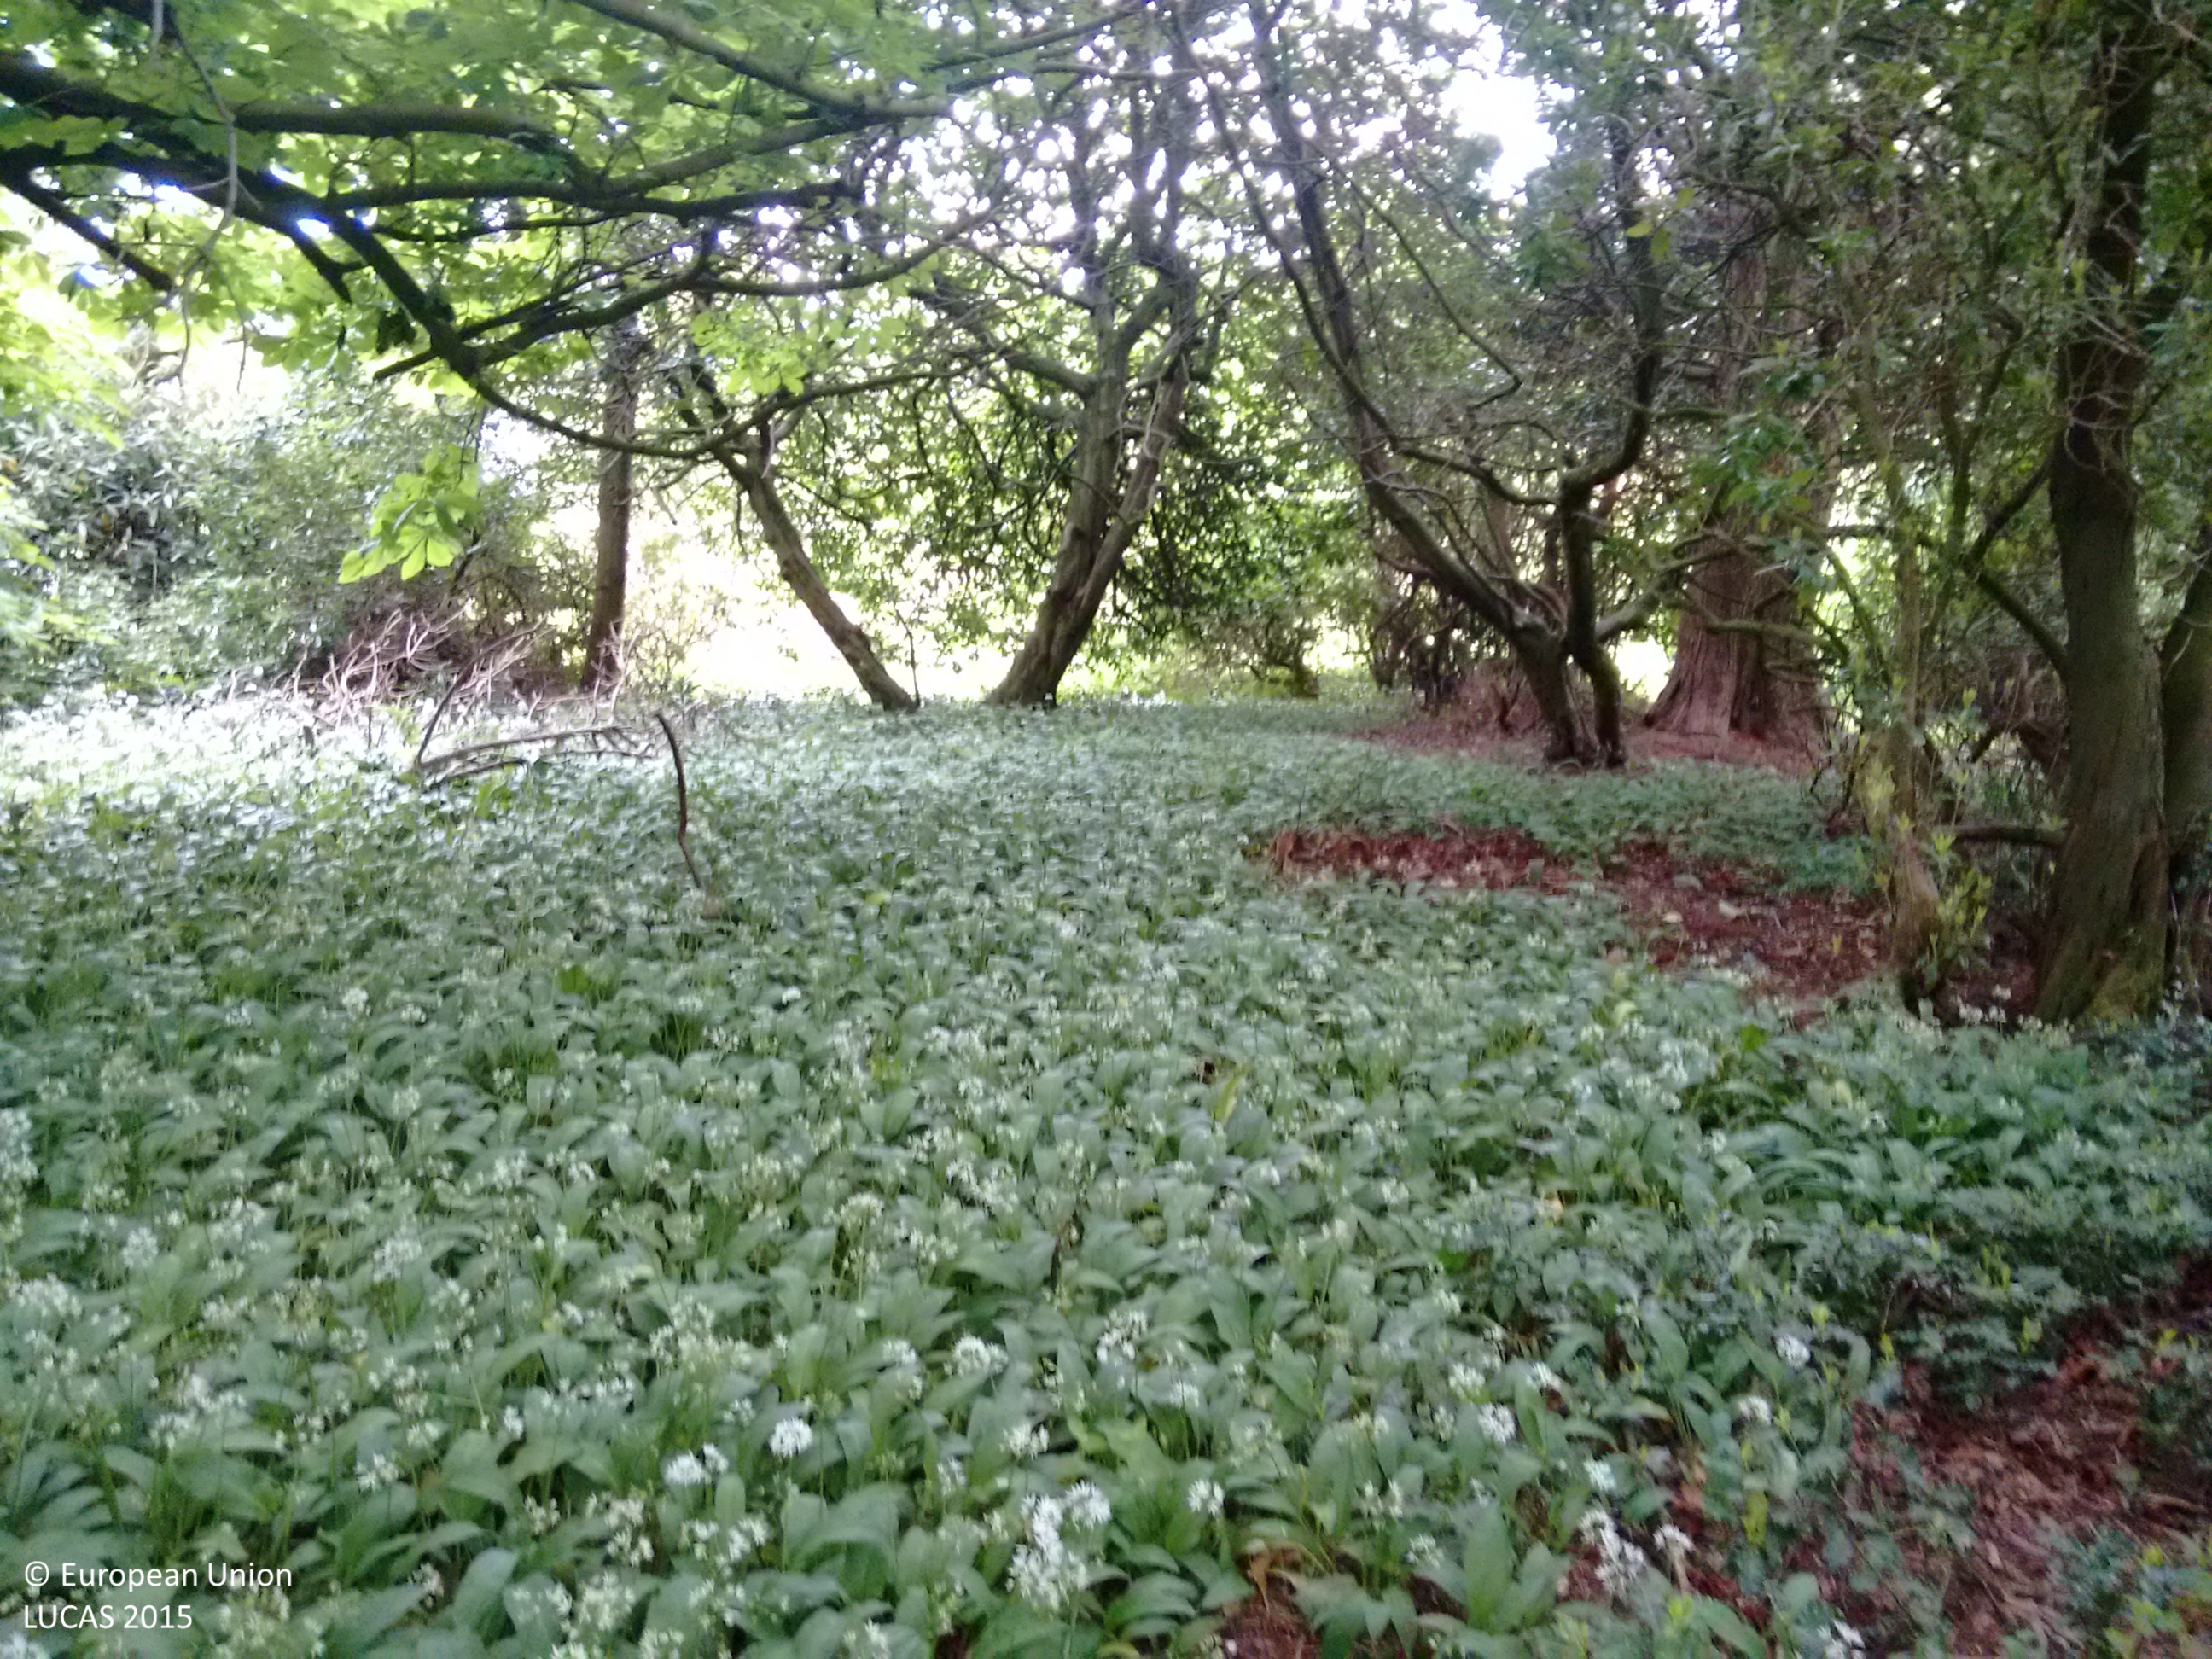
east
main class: Woodland
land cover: Other mixed woodland
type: exotic forest
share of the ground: > 75 %
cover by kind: broadleaved forest trees 75 %, coniferous forest trees 25 %
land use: Semi-natural and natural areas not in use
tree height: > 5 m
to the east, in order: Other mixed woodland; Fences; Pine dominated mixed woodland; Dry stone walls; Other bare soil; Dry stone walls; Pine dominated mixed woodland; Grassland without tree/shrub cover; Pine dominated mixed woodland
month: June
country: GB
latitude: 55.5506
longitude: -1.7955
